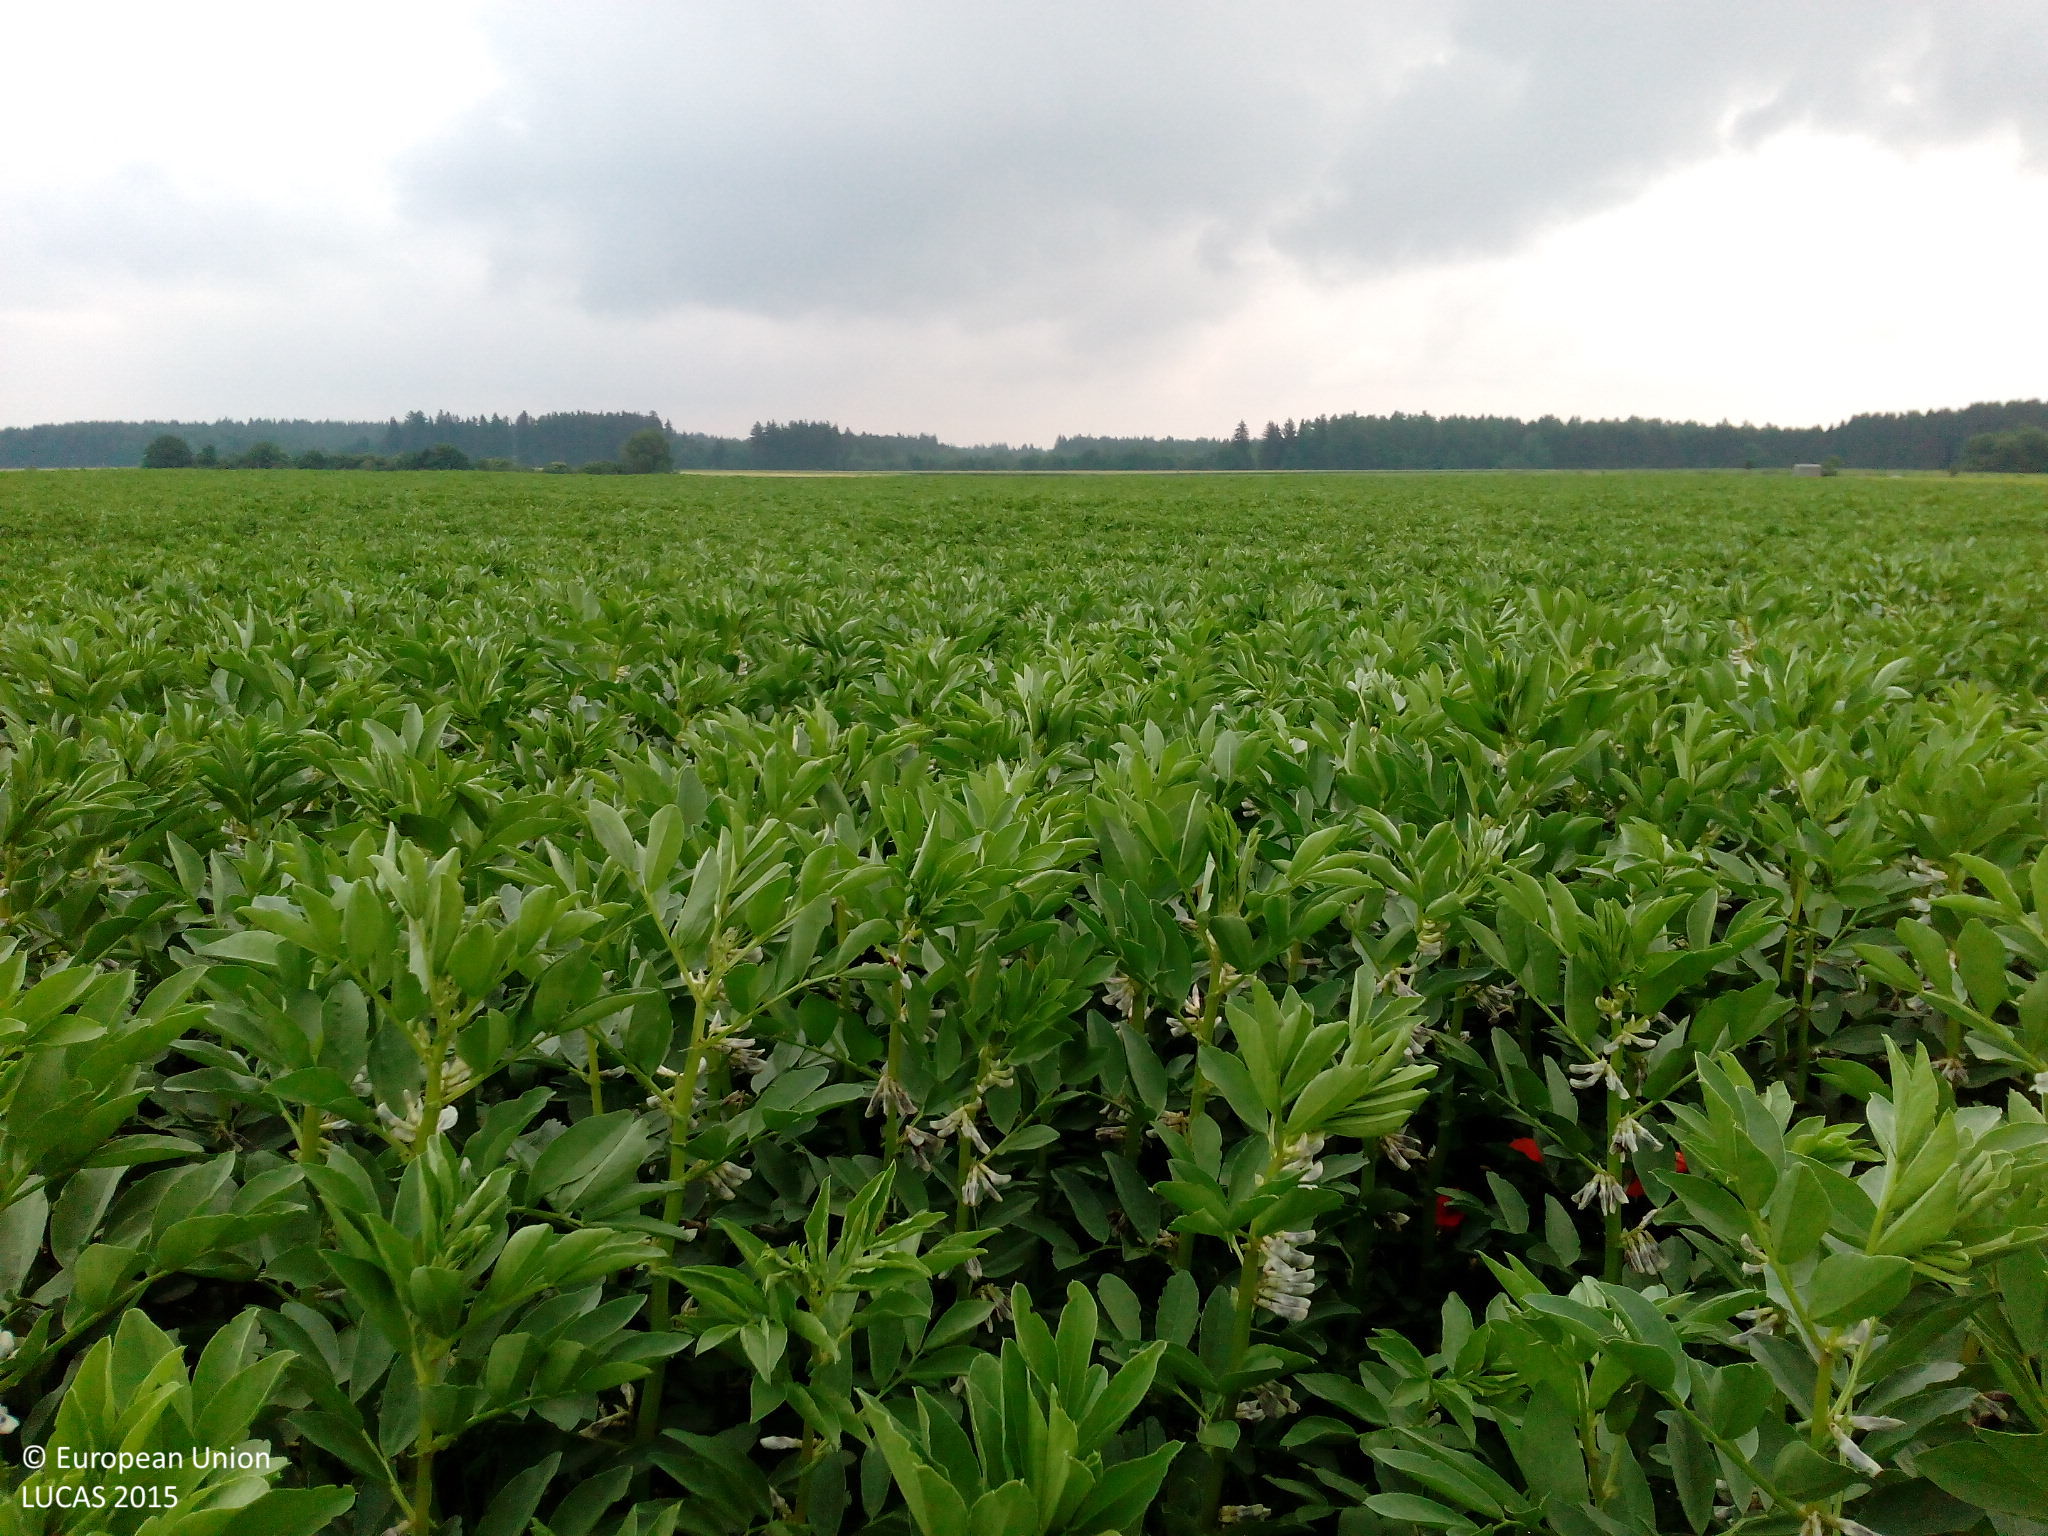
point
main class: Cropland
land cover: Dry pulses
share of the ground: > 75 %
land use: Agriculture (excluding fallow land and kitchen gardens)
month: June
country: DE
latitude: 48.0526
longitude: 11.4078
